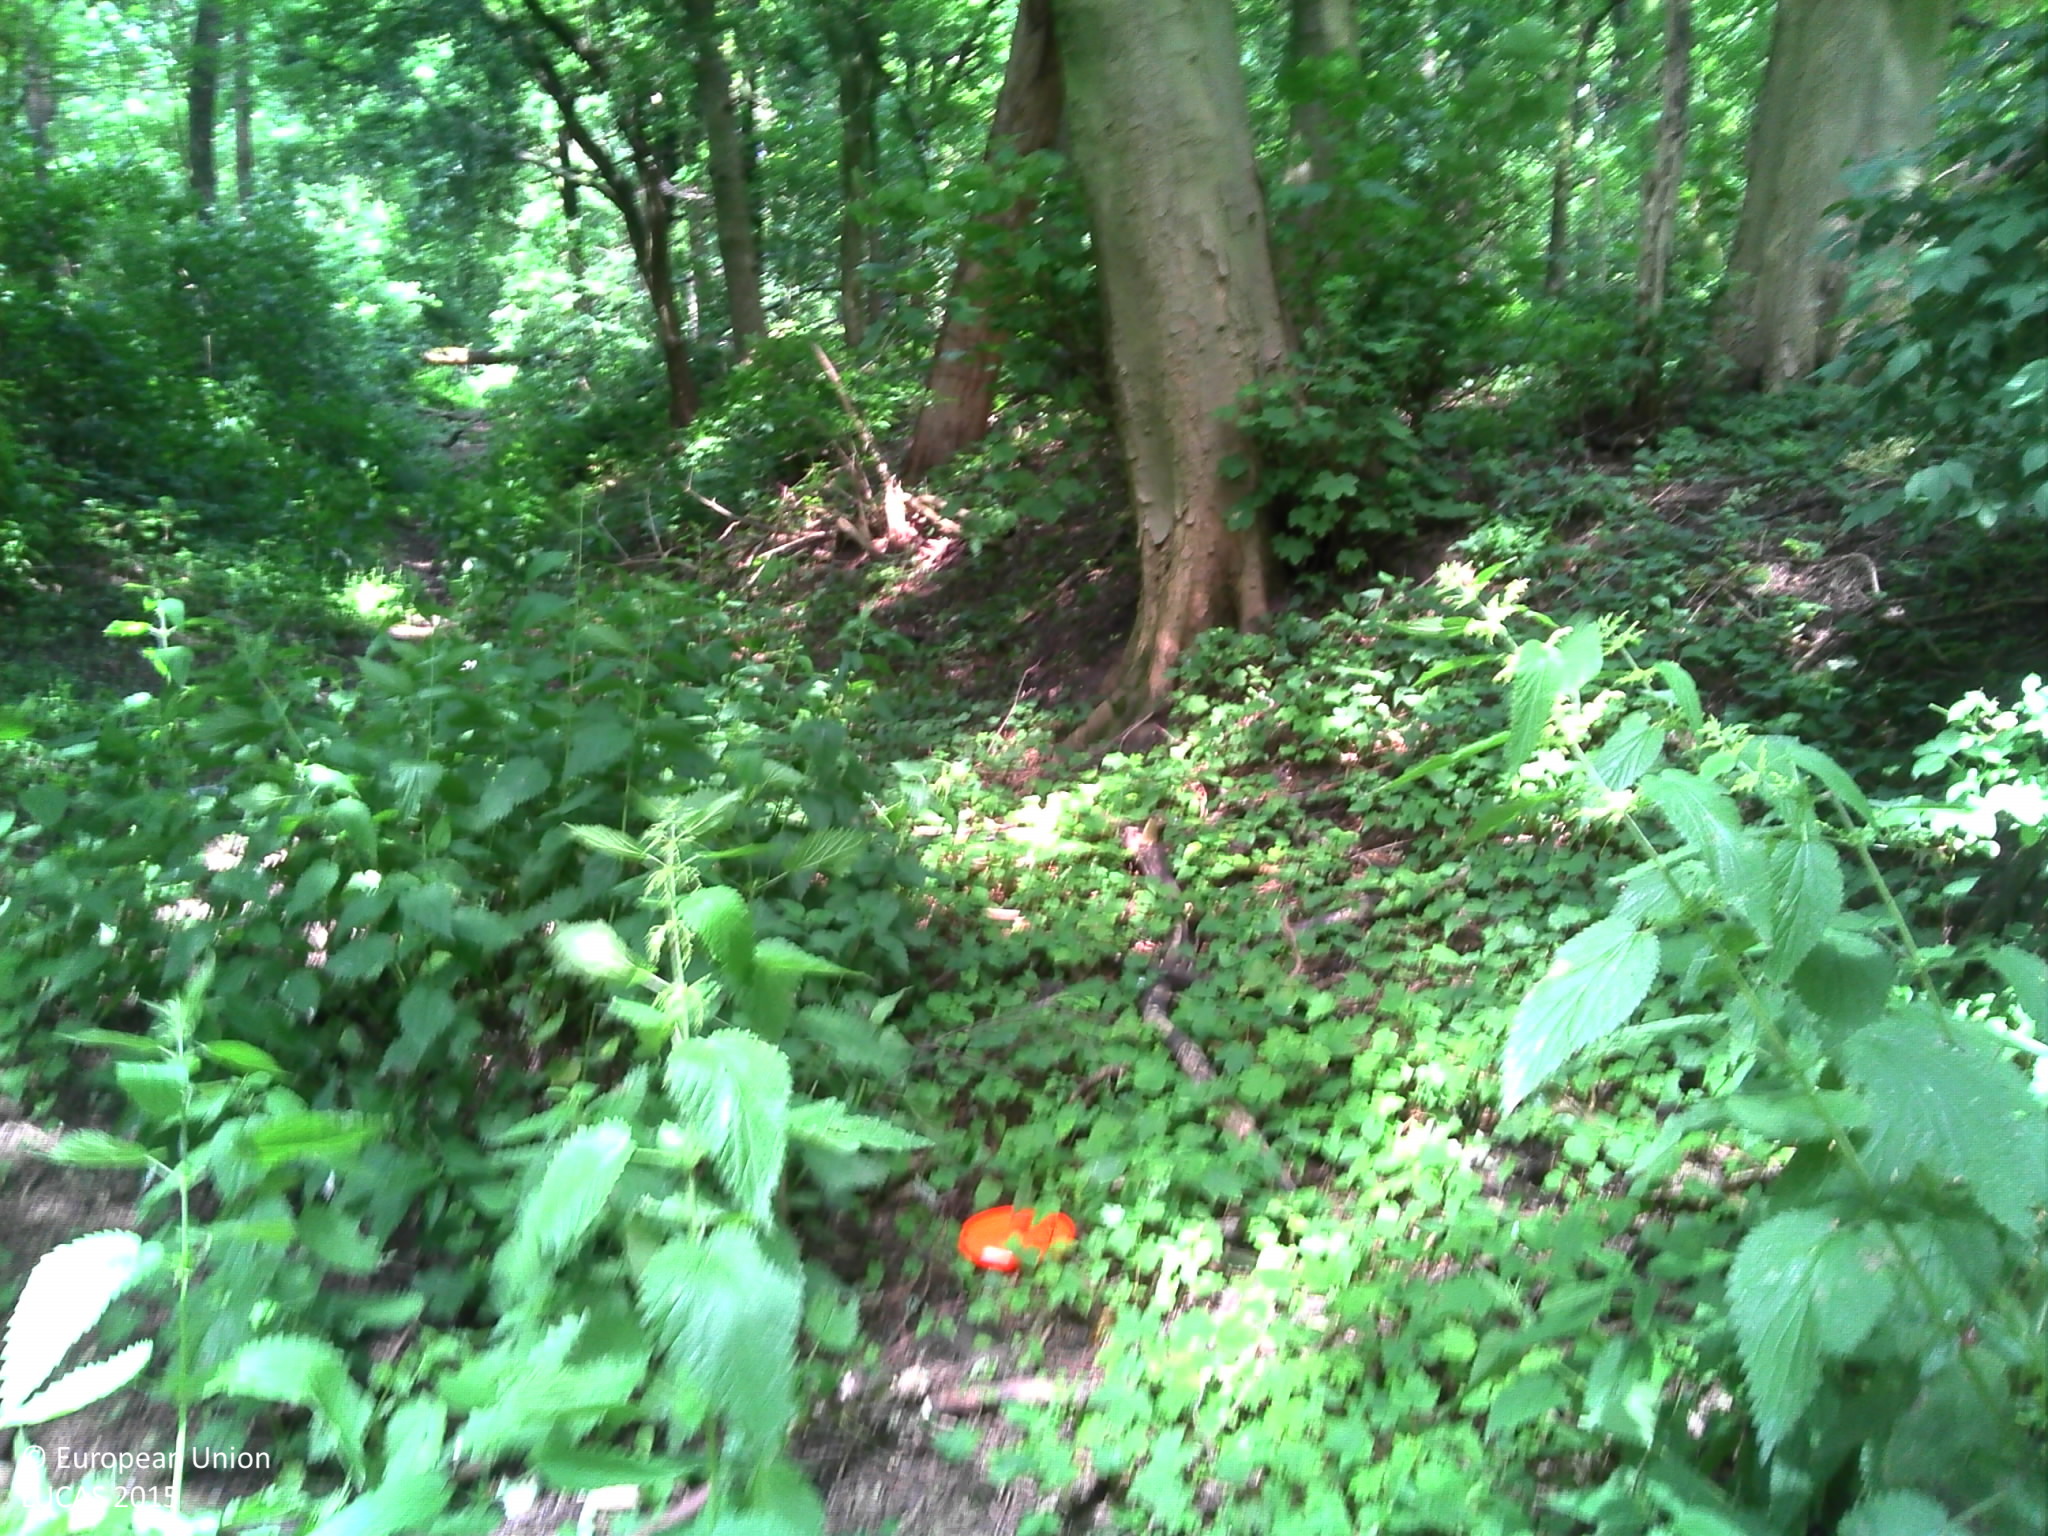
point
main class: Woodland
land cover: Broadleaved woodland
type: mesophytic deciduous forest
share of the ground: > 75 %
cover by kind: broadleaved forest trees 60 %, herbaceous plants 30 %, unconsolidated bare surface 10 %
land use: Forestry
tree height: > 5 m
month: June
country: BE
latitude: 50.4848
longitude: 3.8063
